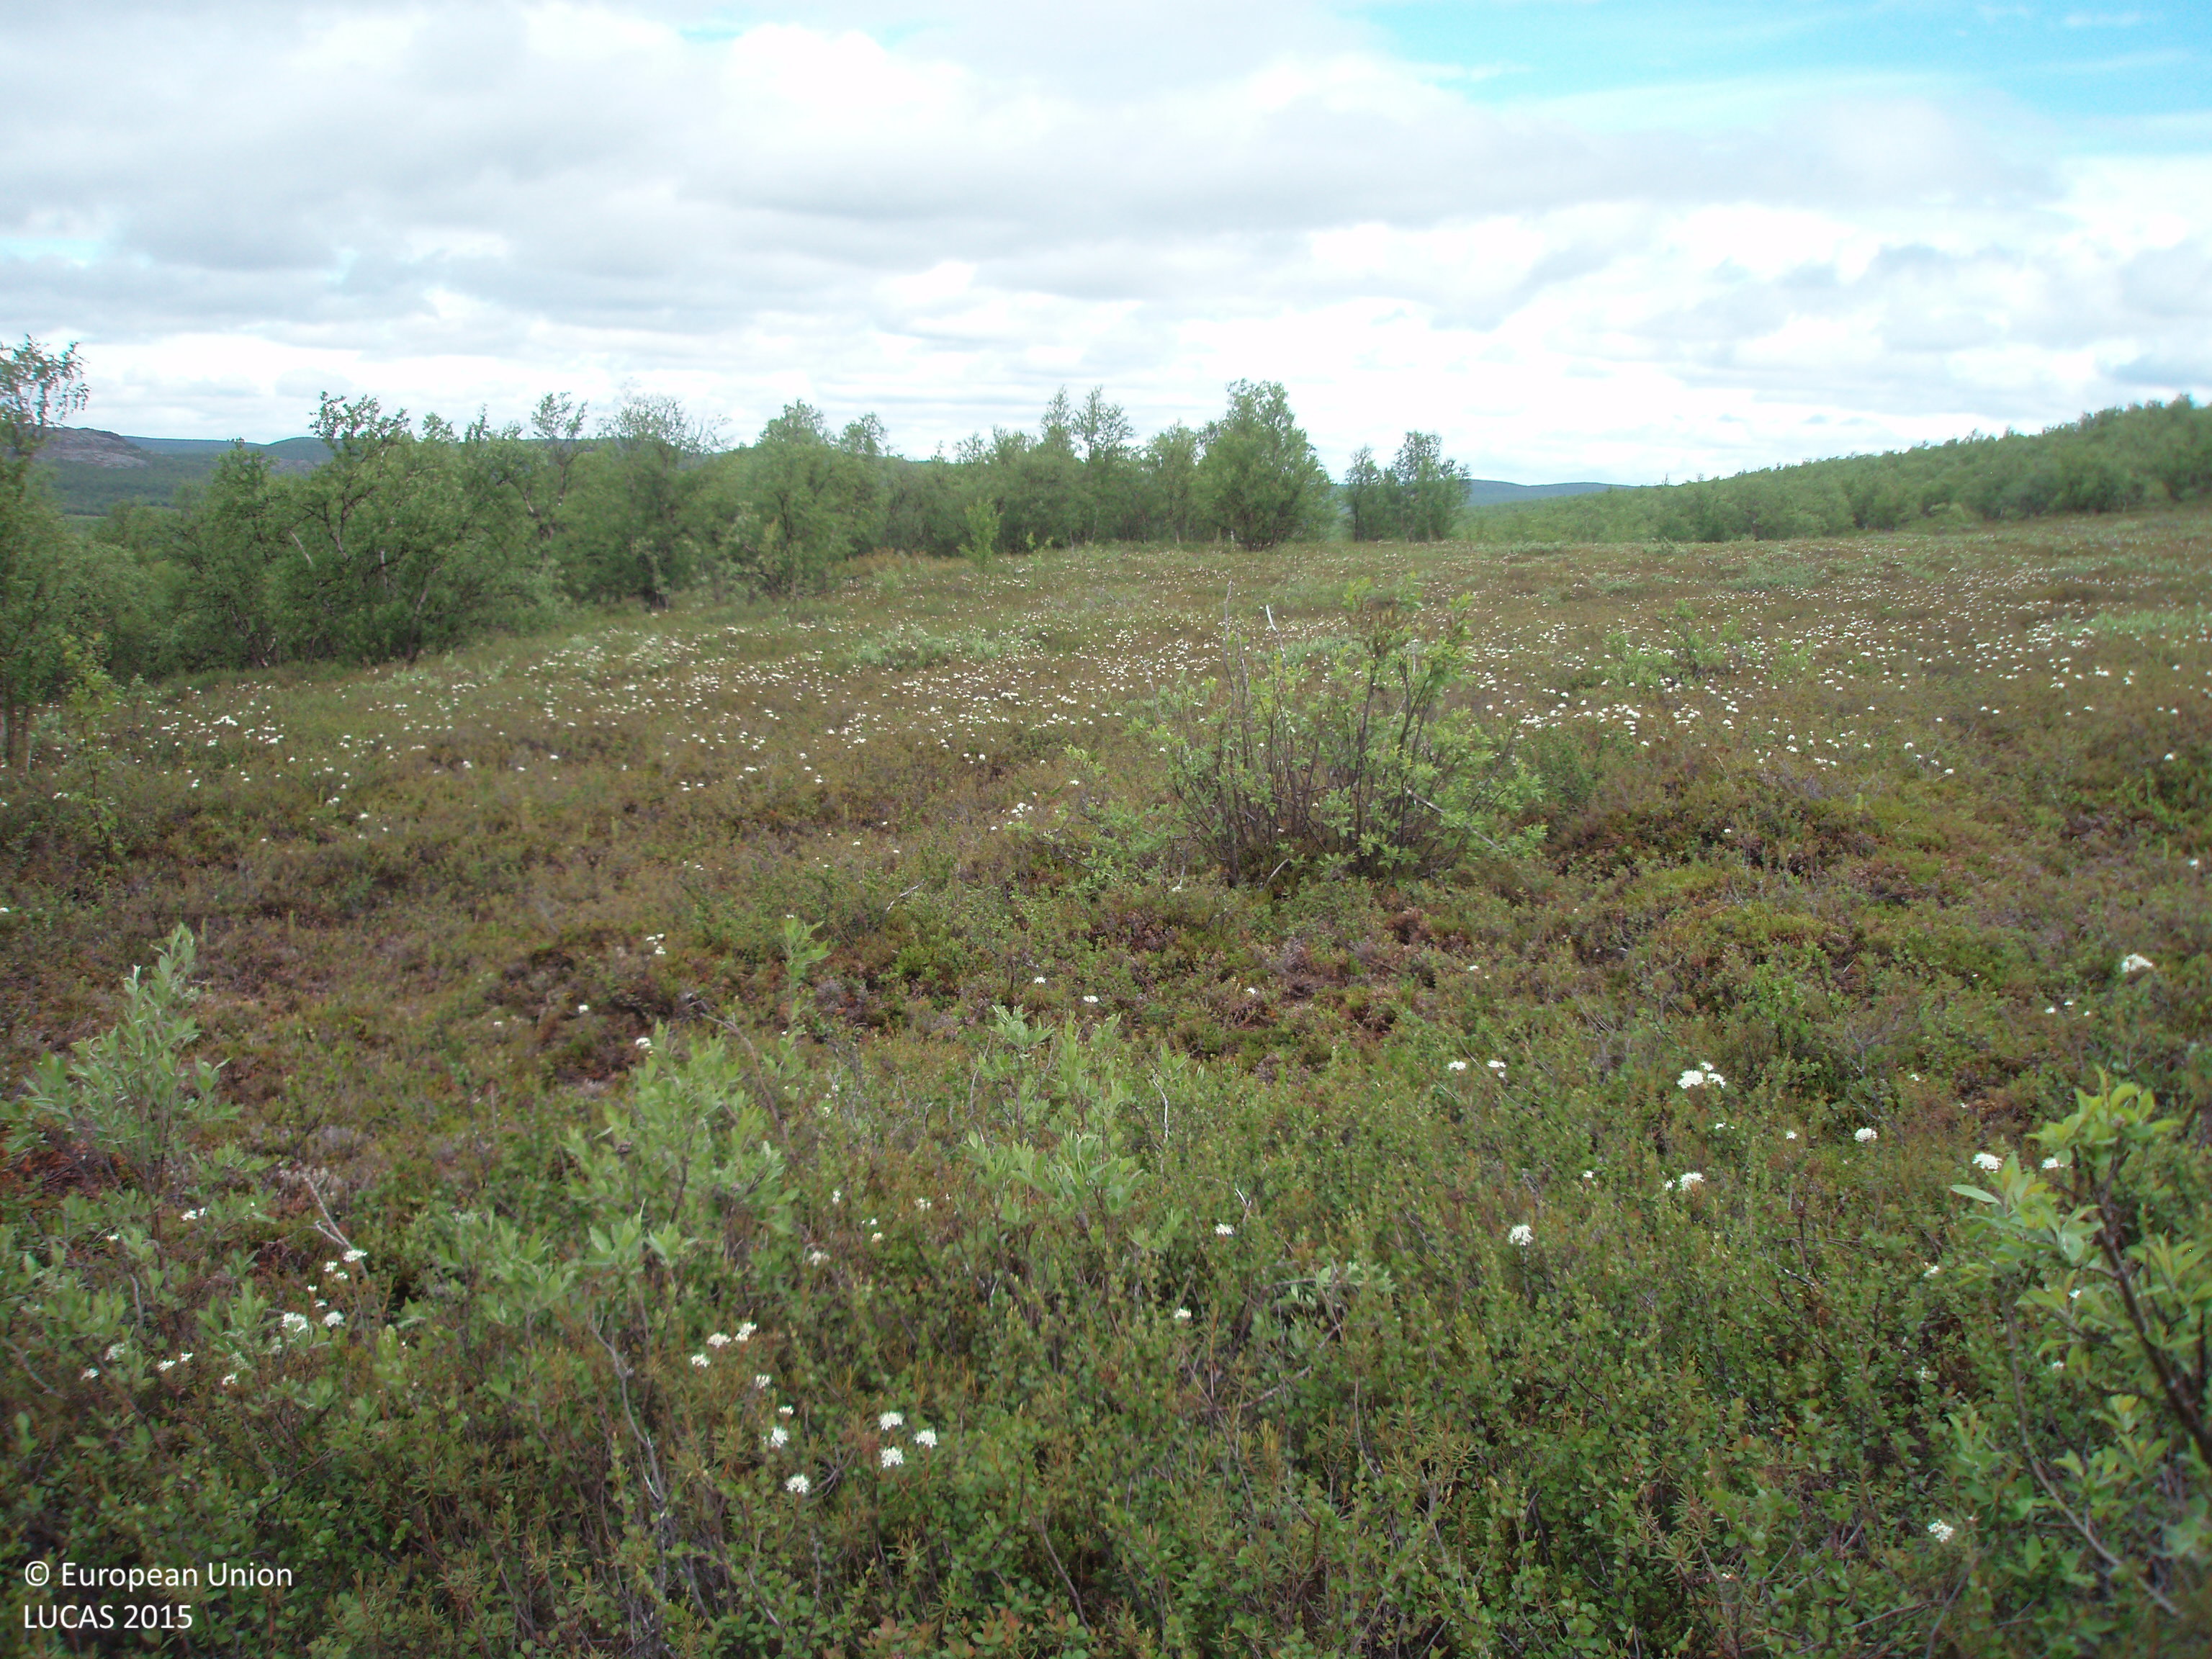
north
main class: Woodland
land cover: Broadleaved woodland
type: boreal forest
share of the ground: 25 - 50 %
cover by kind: broadleaved forest trees 45 %, shrubs 45 %, lichens and mosses 10 %
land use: Forestry
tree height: > 5 m
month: July
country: FI
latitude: 70.0248
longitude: 27.5466
